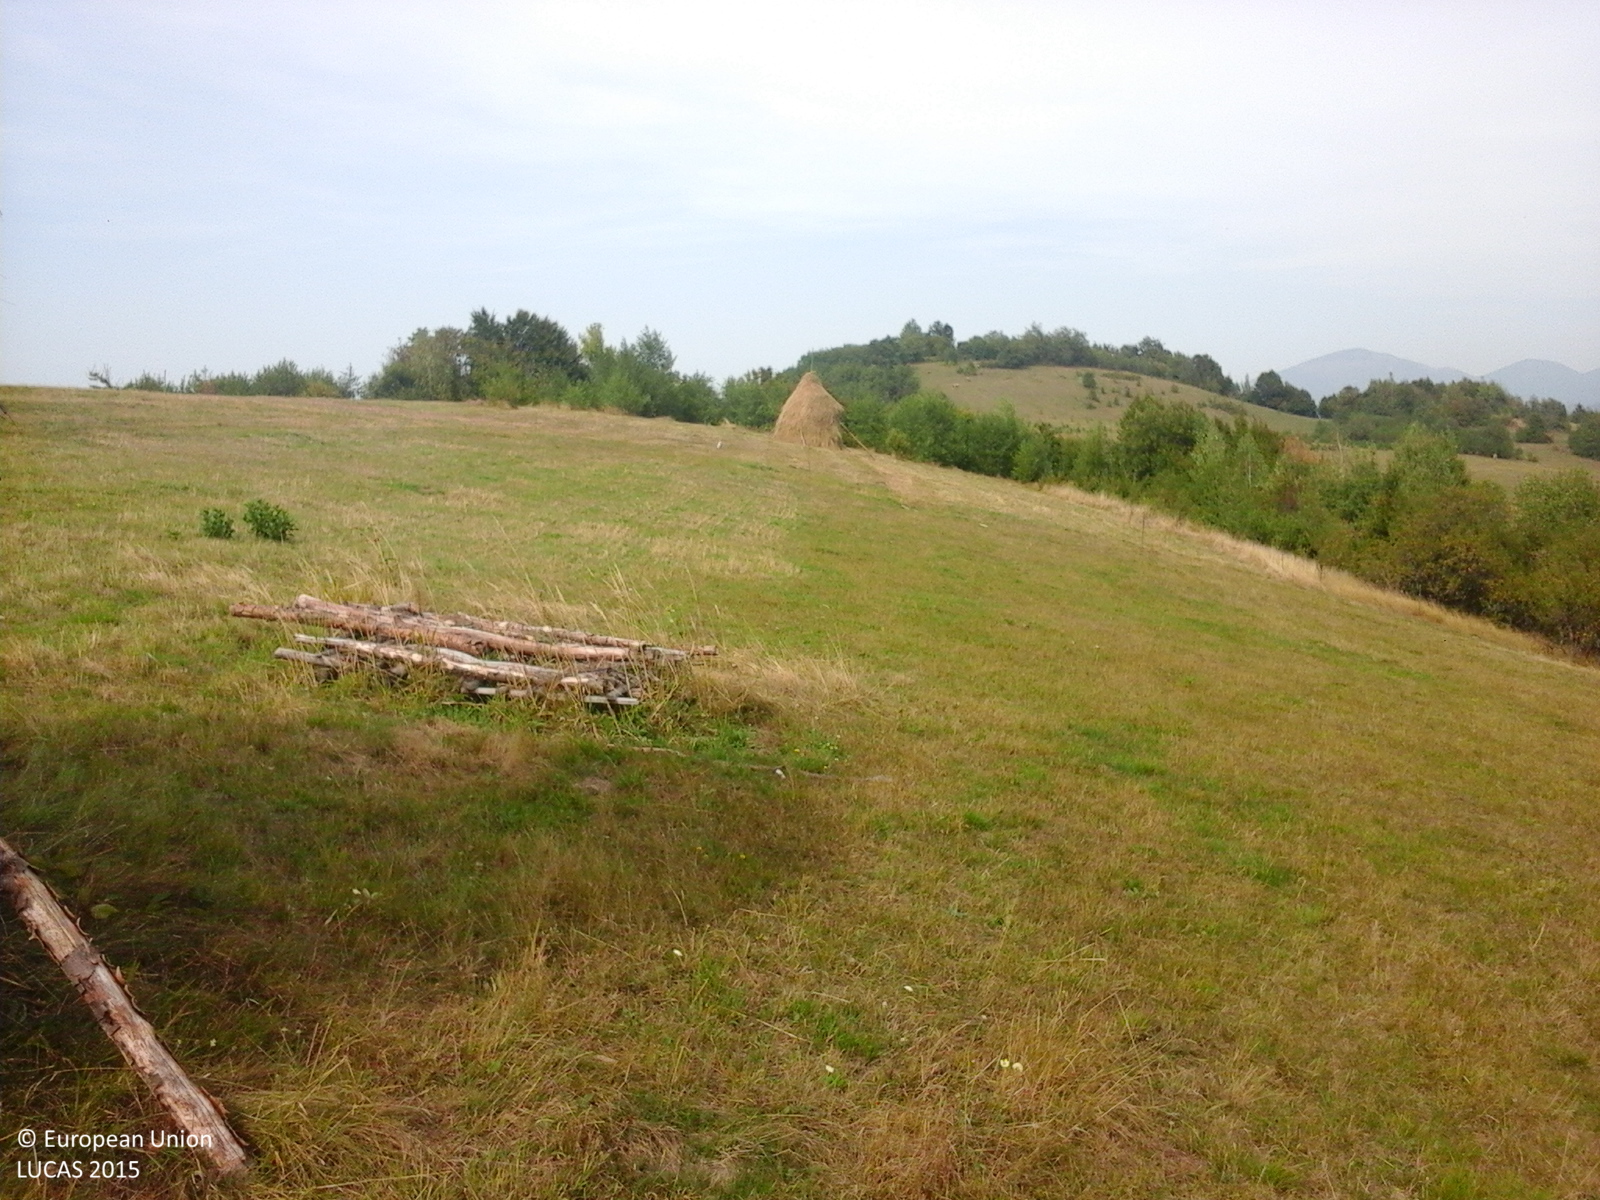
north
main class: Grassland
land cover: Grassland without tree/shrub cover
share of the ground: > 75 %
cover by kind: herbaceous plants 100 %
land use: Agriculture (excluding fallow land and kitchen gardens)
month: September
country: RO
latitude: 47.4143
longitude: 24.0126
